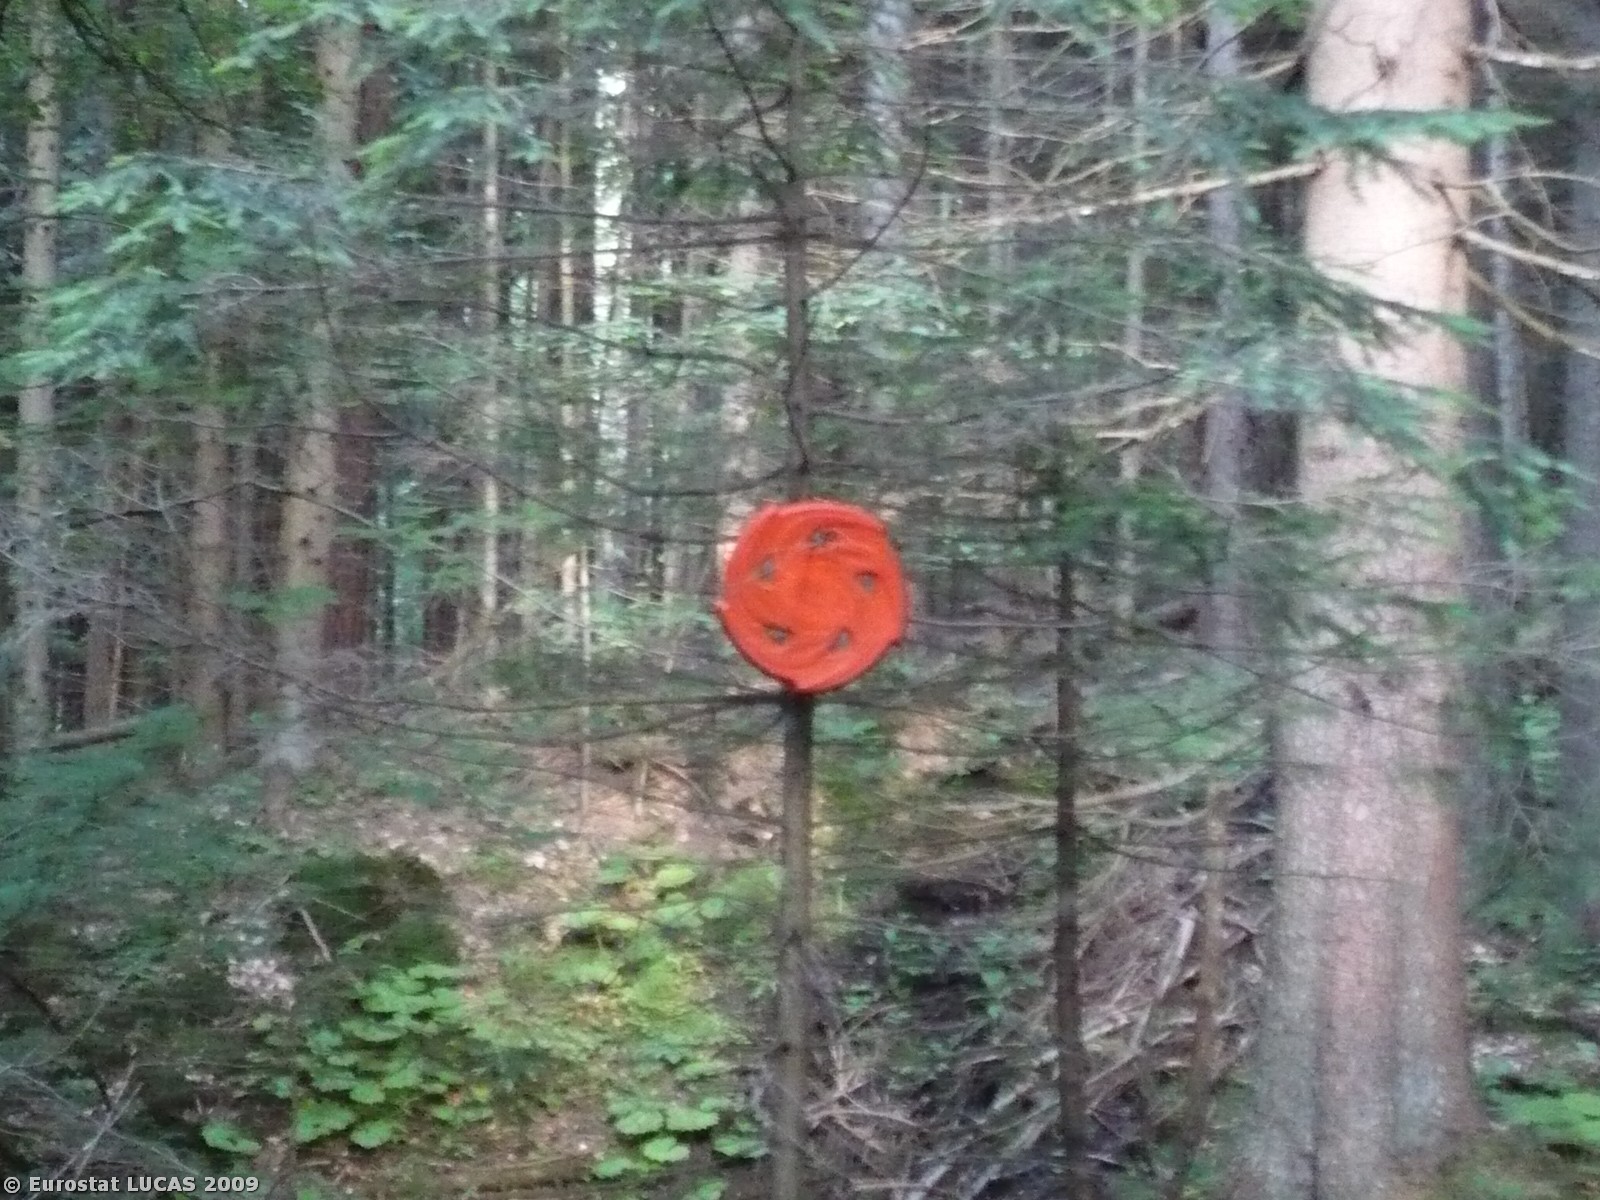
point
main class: Woodland
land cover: Coniferous woodland
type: alpine coniferous forest
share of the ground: > 75 %
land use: Forestry
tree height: > 5 m
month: June
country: SI
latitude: 46.4816
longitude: 13.8136
